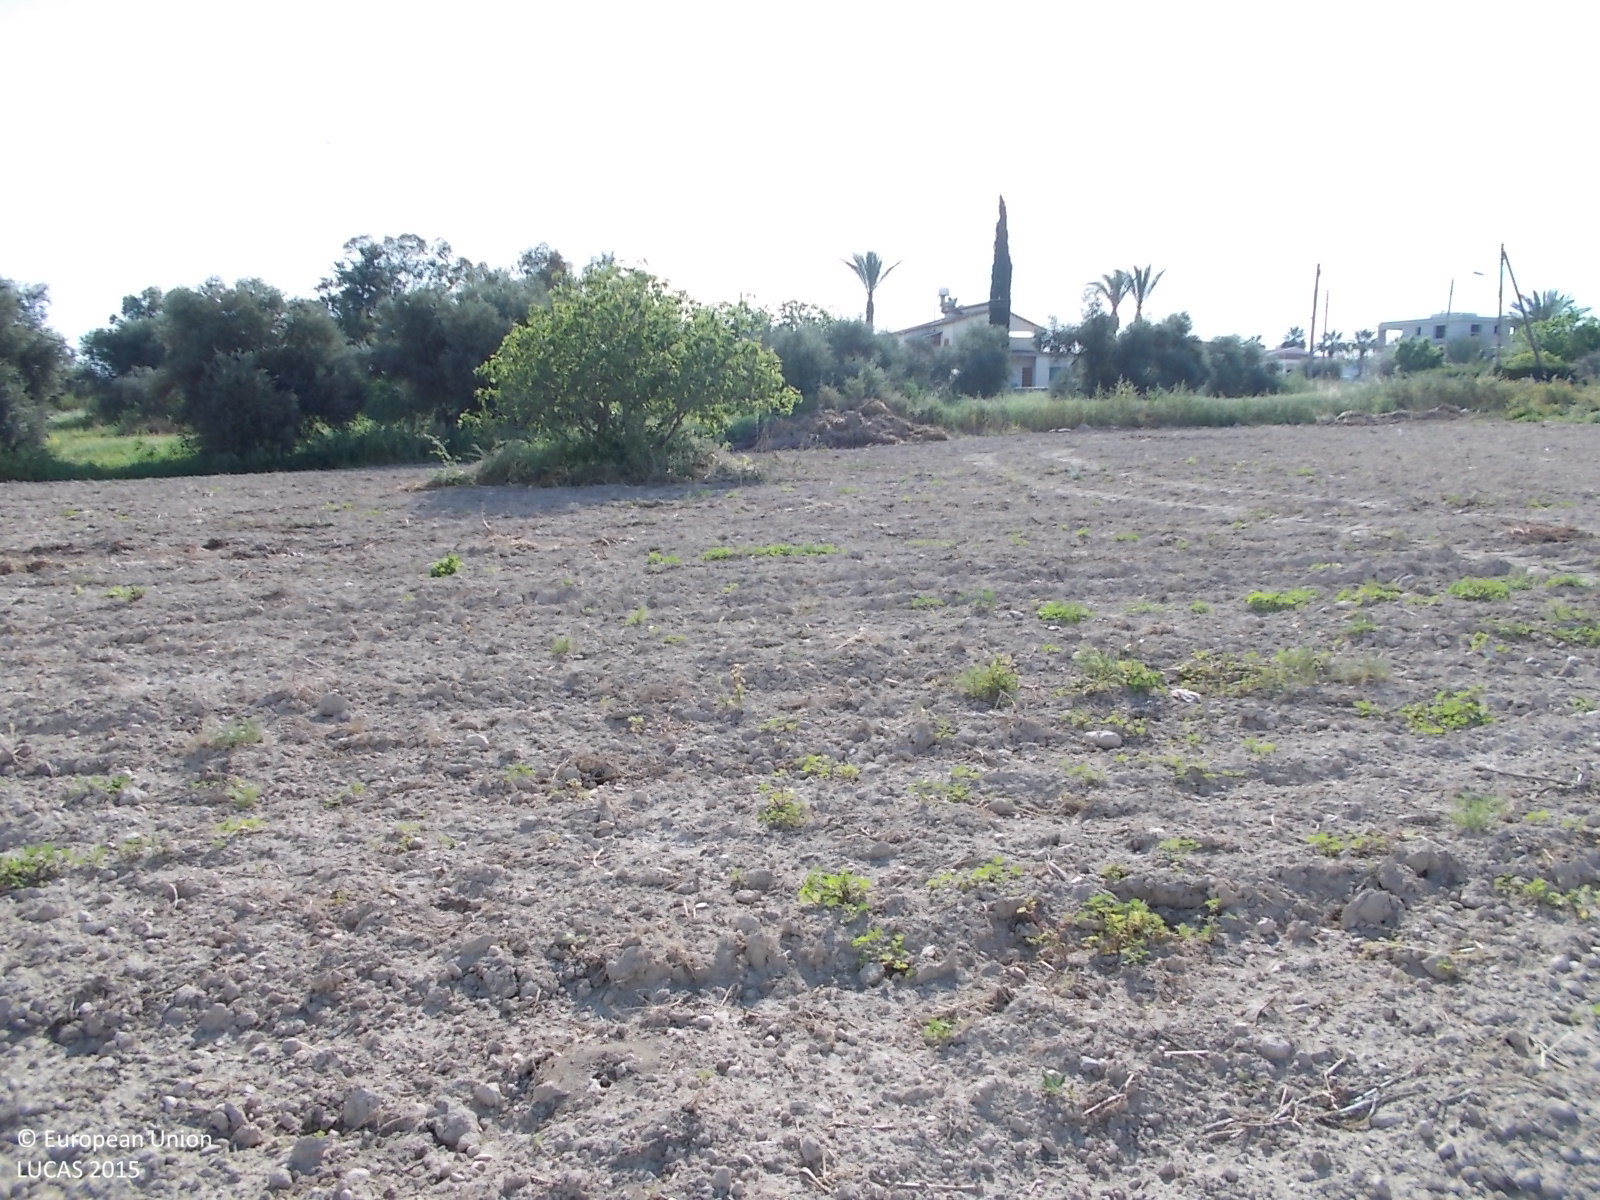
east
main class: Cropland
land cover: Other fresh vegetables
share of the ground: 10 - 25 %
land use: Agriculture (excluding fallow land and kitchen gardens)
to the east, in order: Other fresh vegetables; Single bushes/trees; Other bare soil; Olive groves; Nuts trees; Common wheat; Artificial constructions in urban areas; Abandoned hedges; Common wheat; Abandoned hedges; Electric lines; Paved roads, cycling and walking lanes; Abandoned hedges; Common wheat
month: April
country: CY
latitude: 35.0662
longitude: 33.5438
